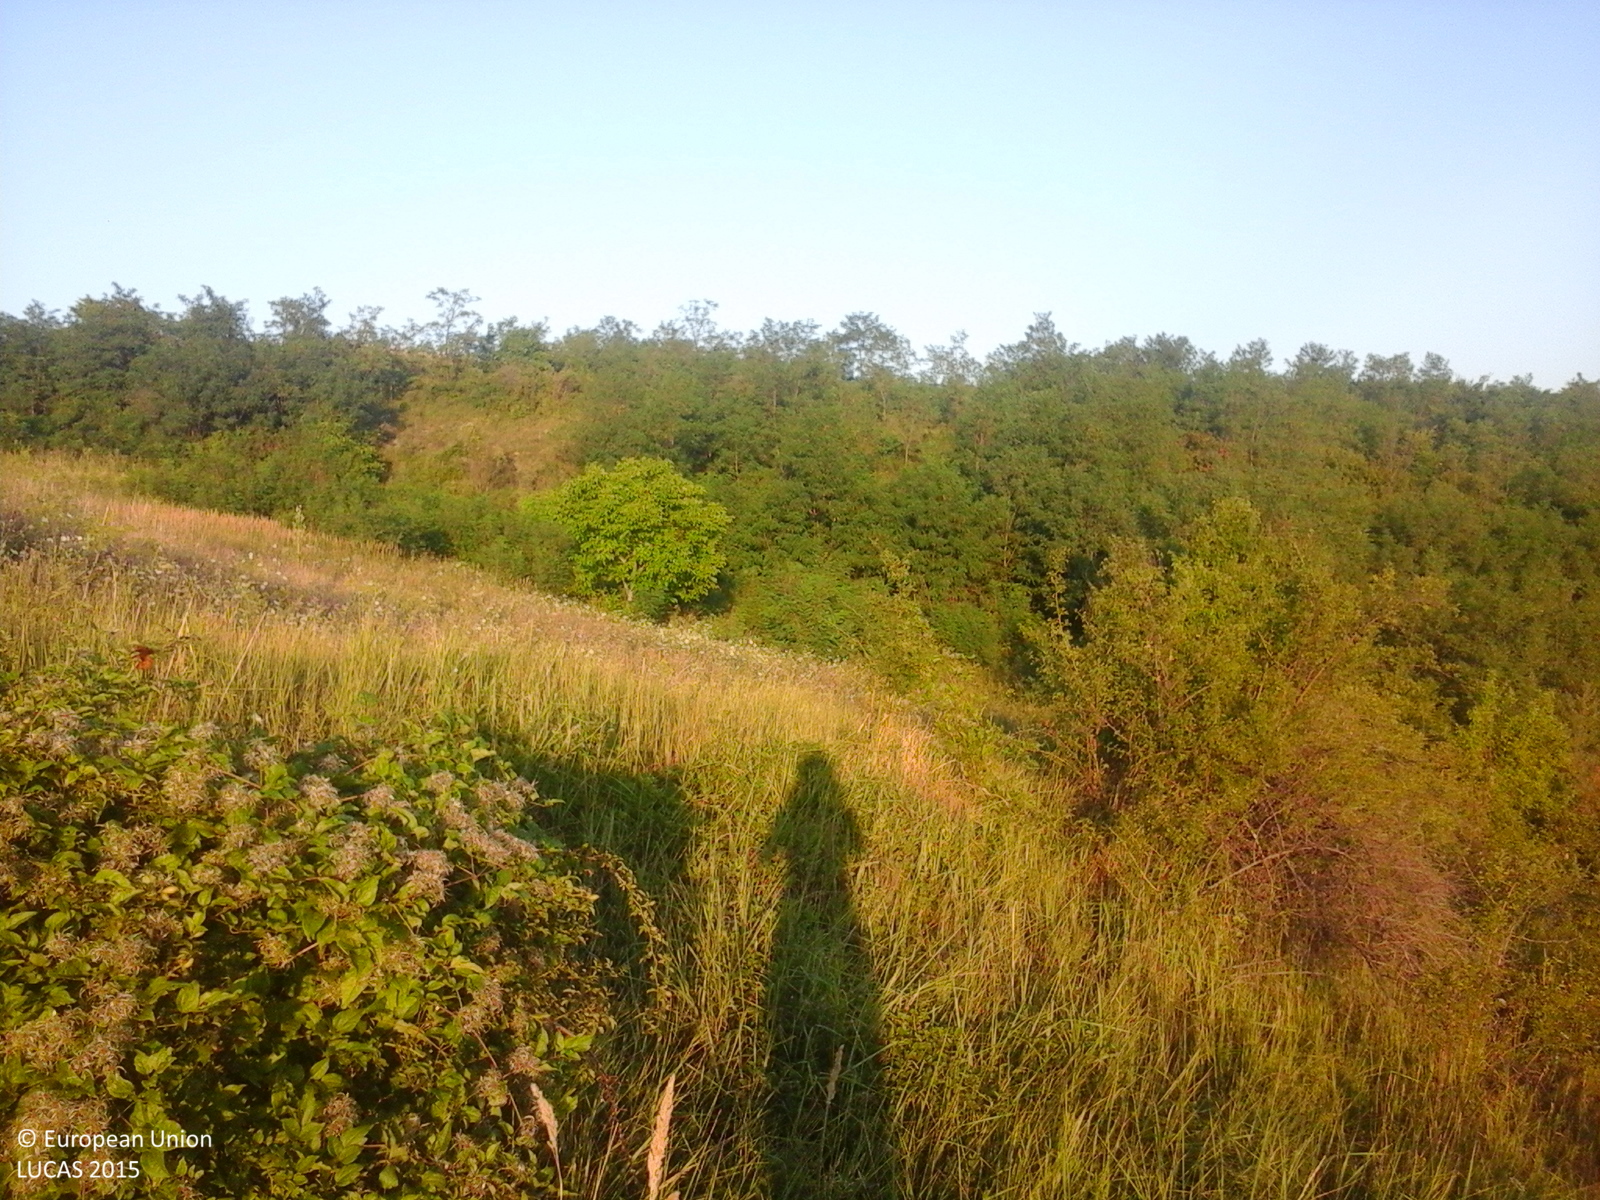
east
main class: Grassland
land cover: Grassland with sparse tree/shrub cover
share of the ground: > 75 %
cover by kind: herbaceous plants 85 %, shrubs 10 %, broadleaved forest trees 5 %
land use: Agriculture (excluding fallow land and kitchen gardens)
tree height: < 5 m
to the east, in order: Grassland with sparse tree/shrub cover; Spontaneously vegetated surfaces; Broadleaved woodland; Shrubland with sparse tree cover; Maize; Lucerne
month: August
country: RO
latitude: 46.2719
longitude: 26.8419
